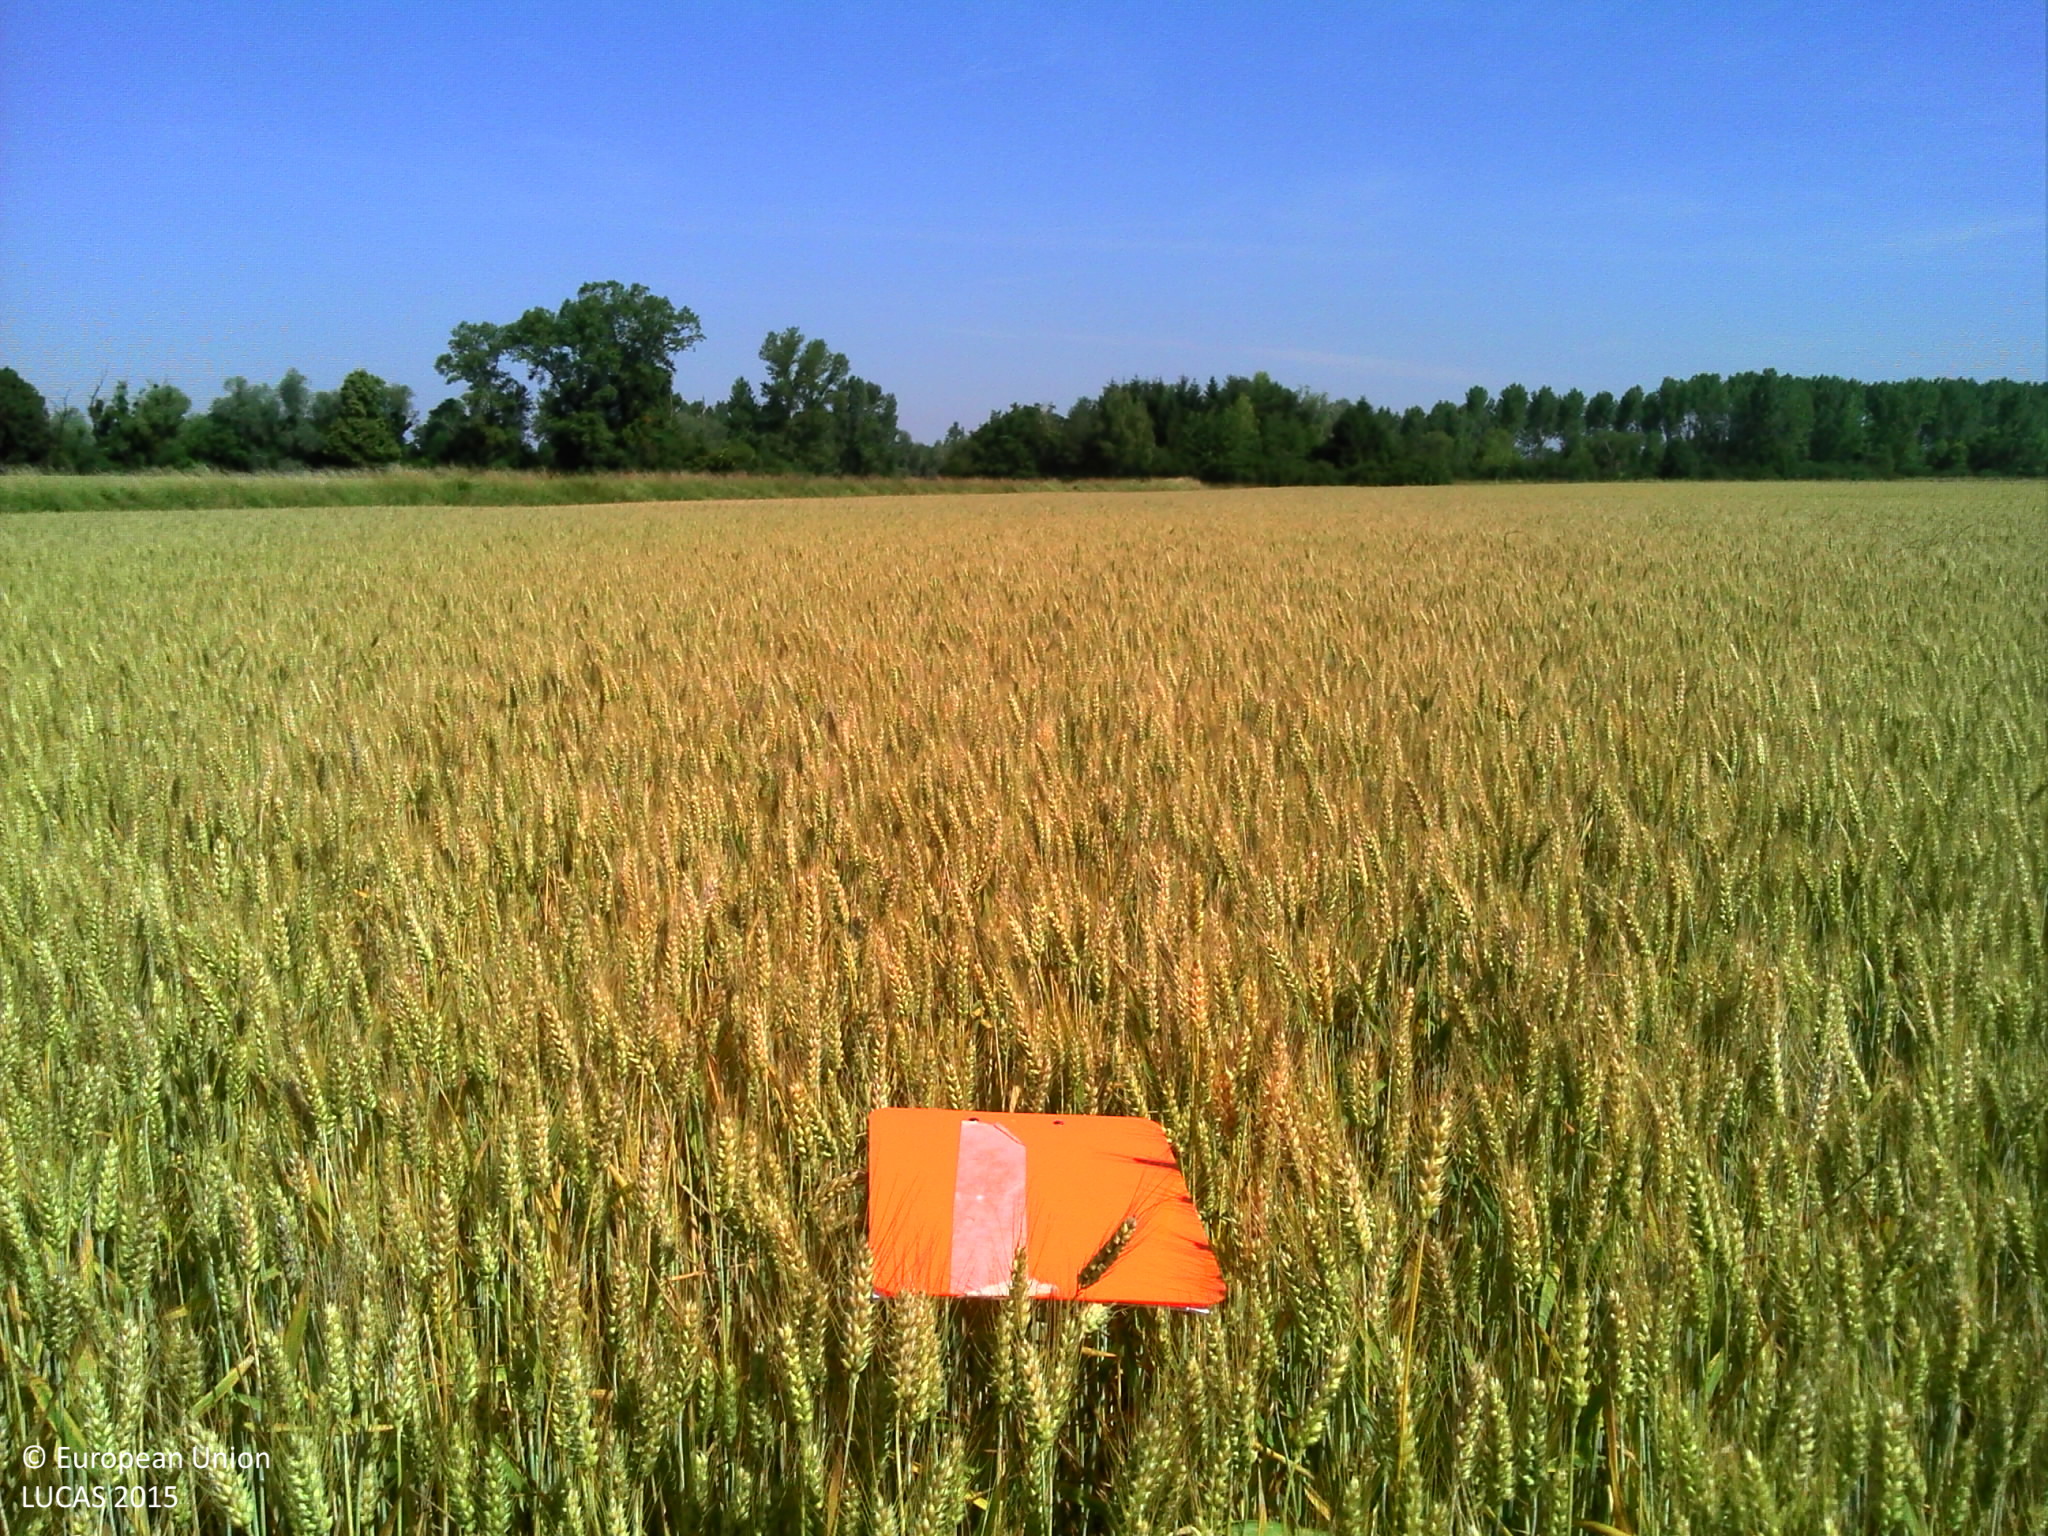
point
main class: Cropland
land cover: Common wheat
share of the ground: > 75 %
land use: Agriculture (excluding fallow land and kitchen gardens)
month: June
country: FR
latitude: 46.9160
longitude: 5.3140
